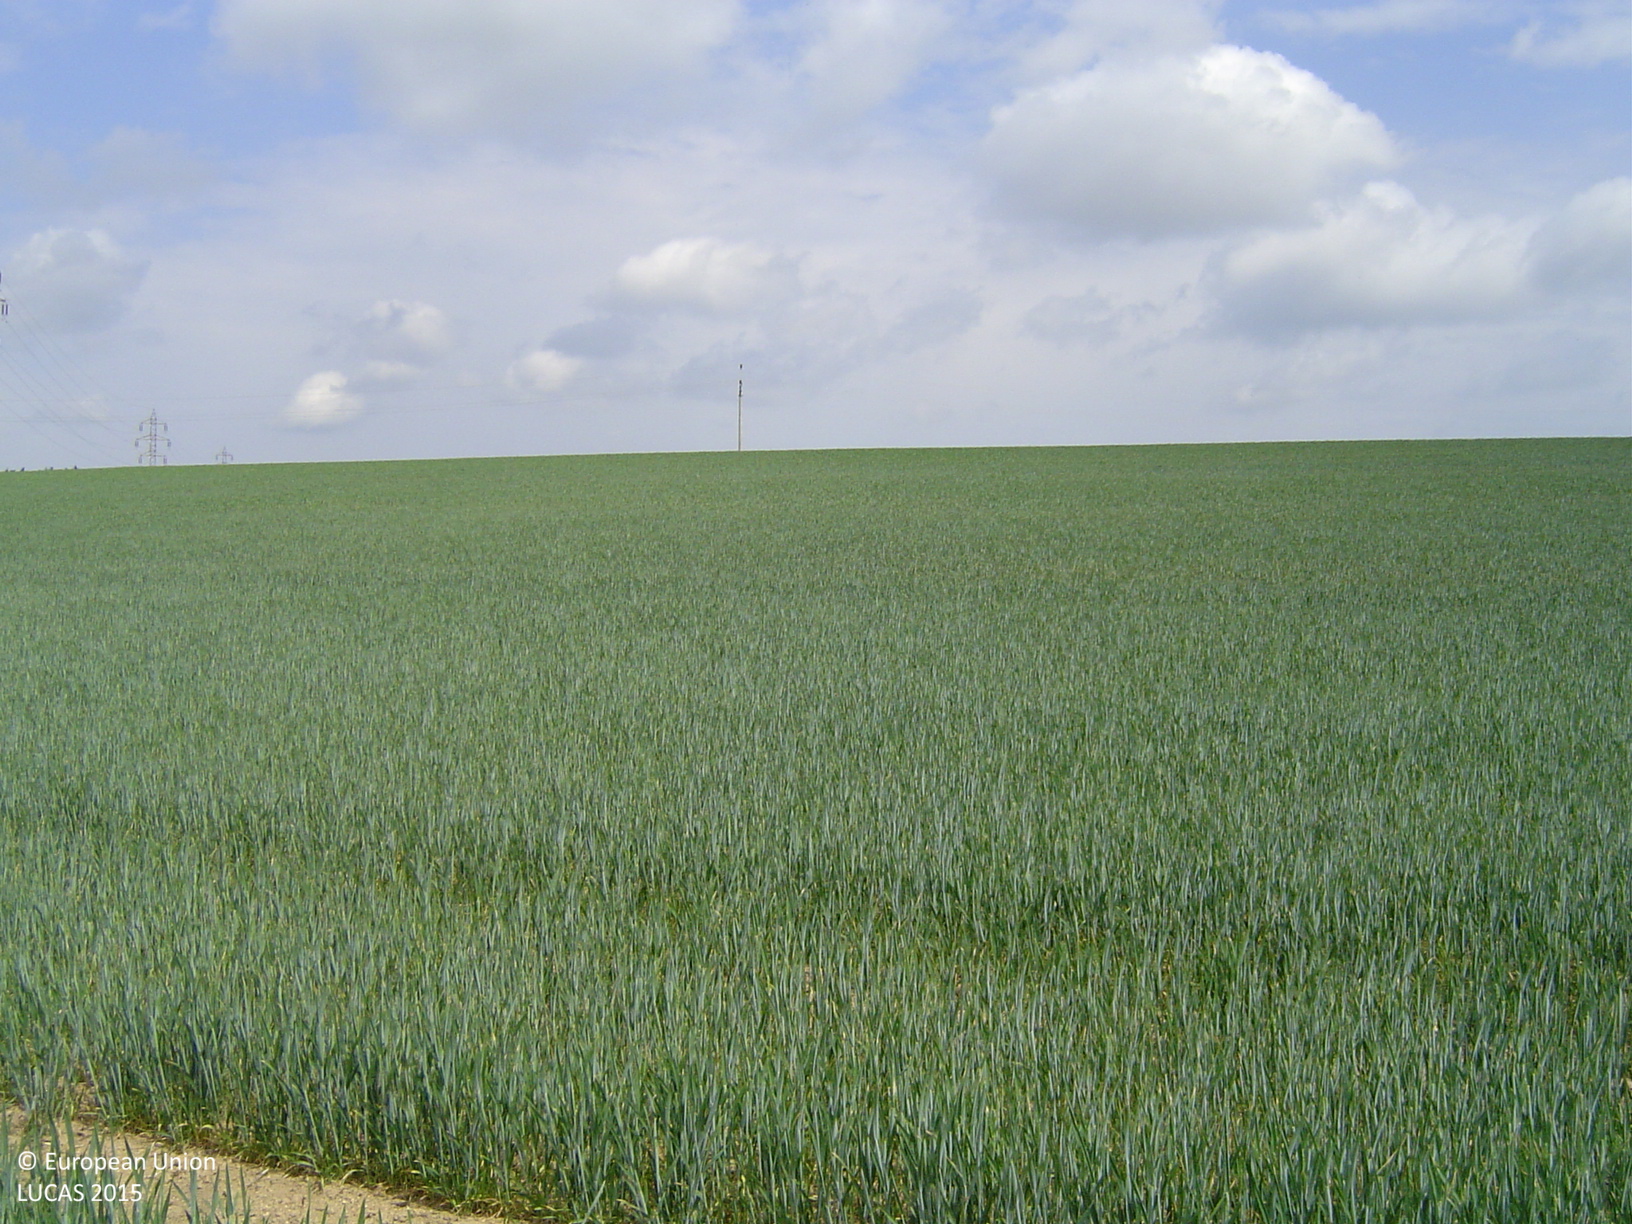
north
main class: Cropland
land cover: Common wheat
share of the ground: > 75 %
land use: Agriculture (excluding fallow land and kitchen gardens)
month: May
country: CZ
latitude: 49.2936
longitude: 16.2072
